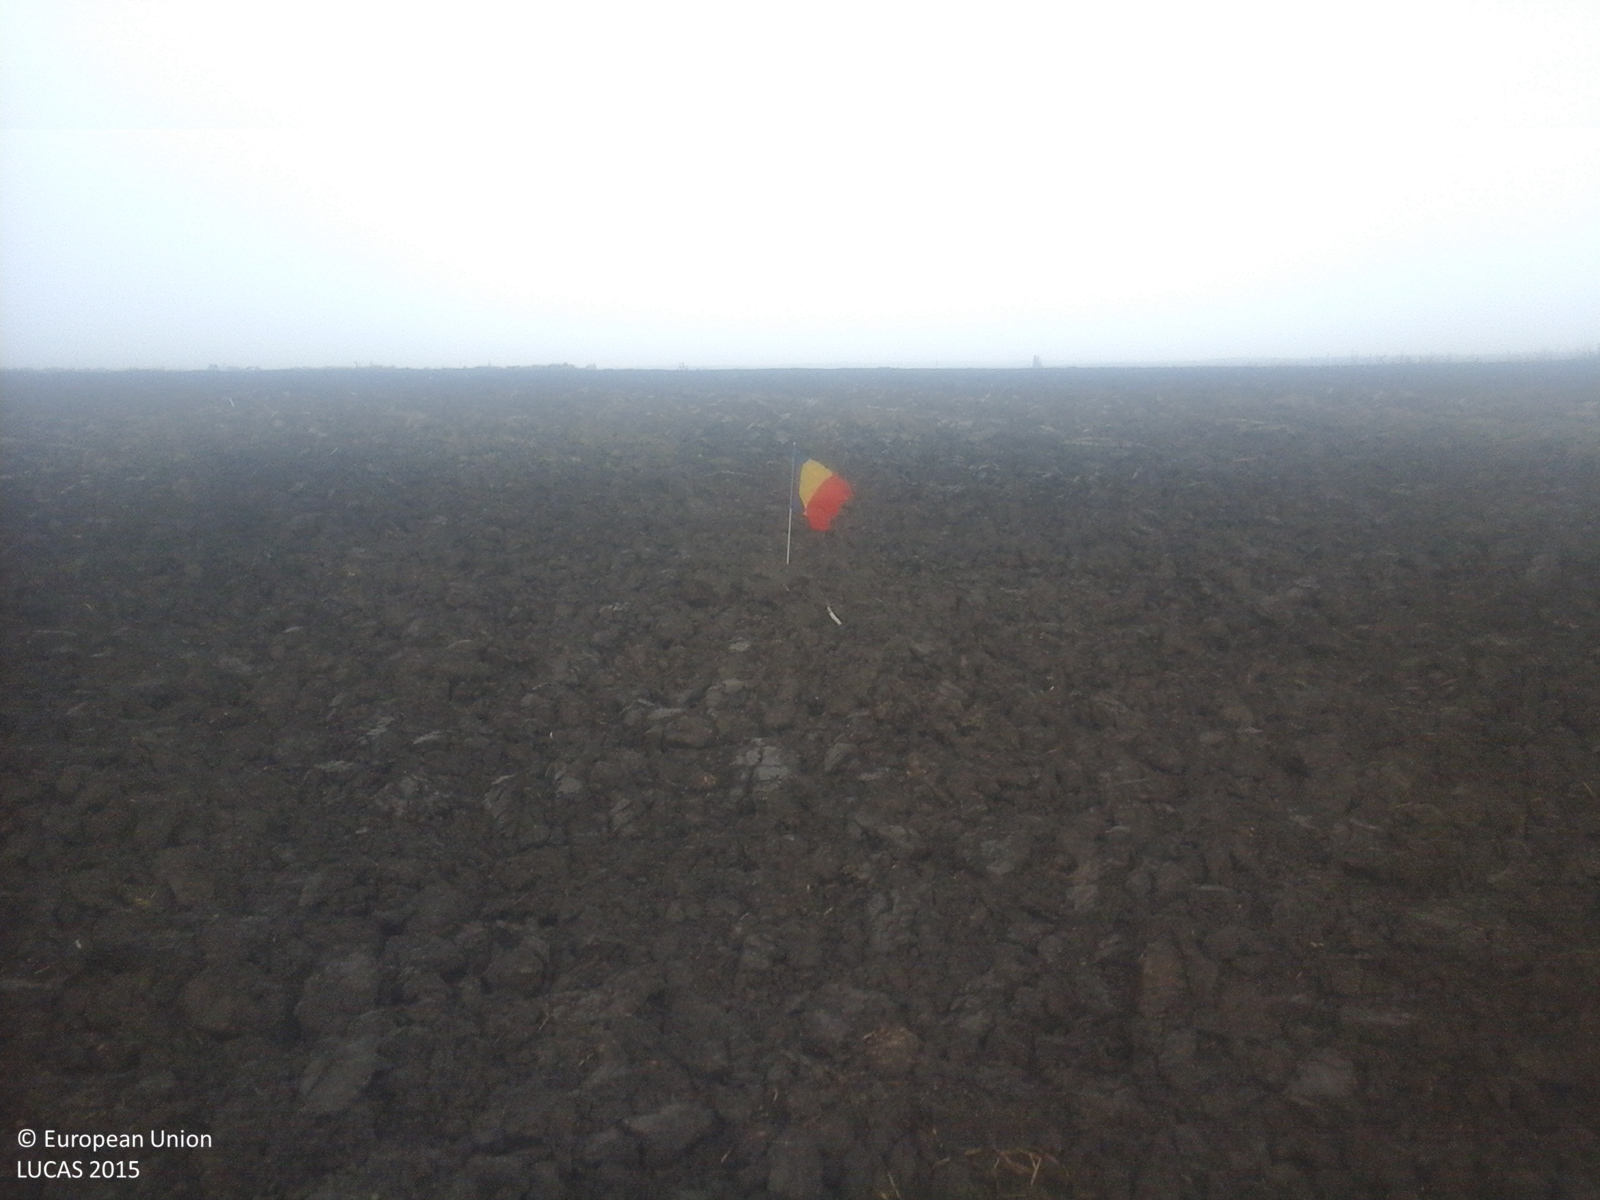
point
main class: Cropland
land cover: Rape and turnip rape
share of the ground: < 10 %
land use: Agriculture (excluding fallow land and kitchen gardens)
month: September
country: RO
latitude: 47.5358
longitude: 22.4236
